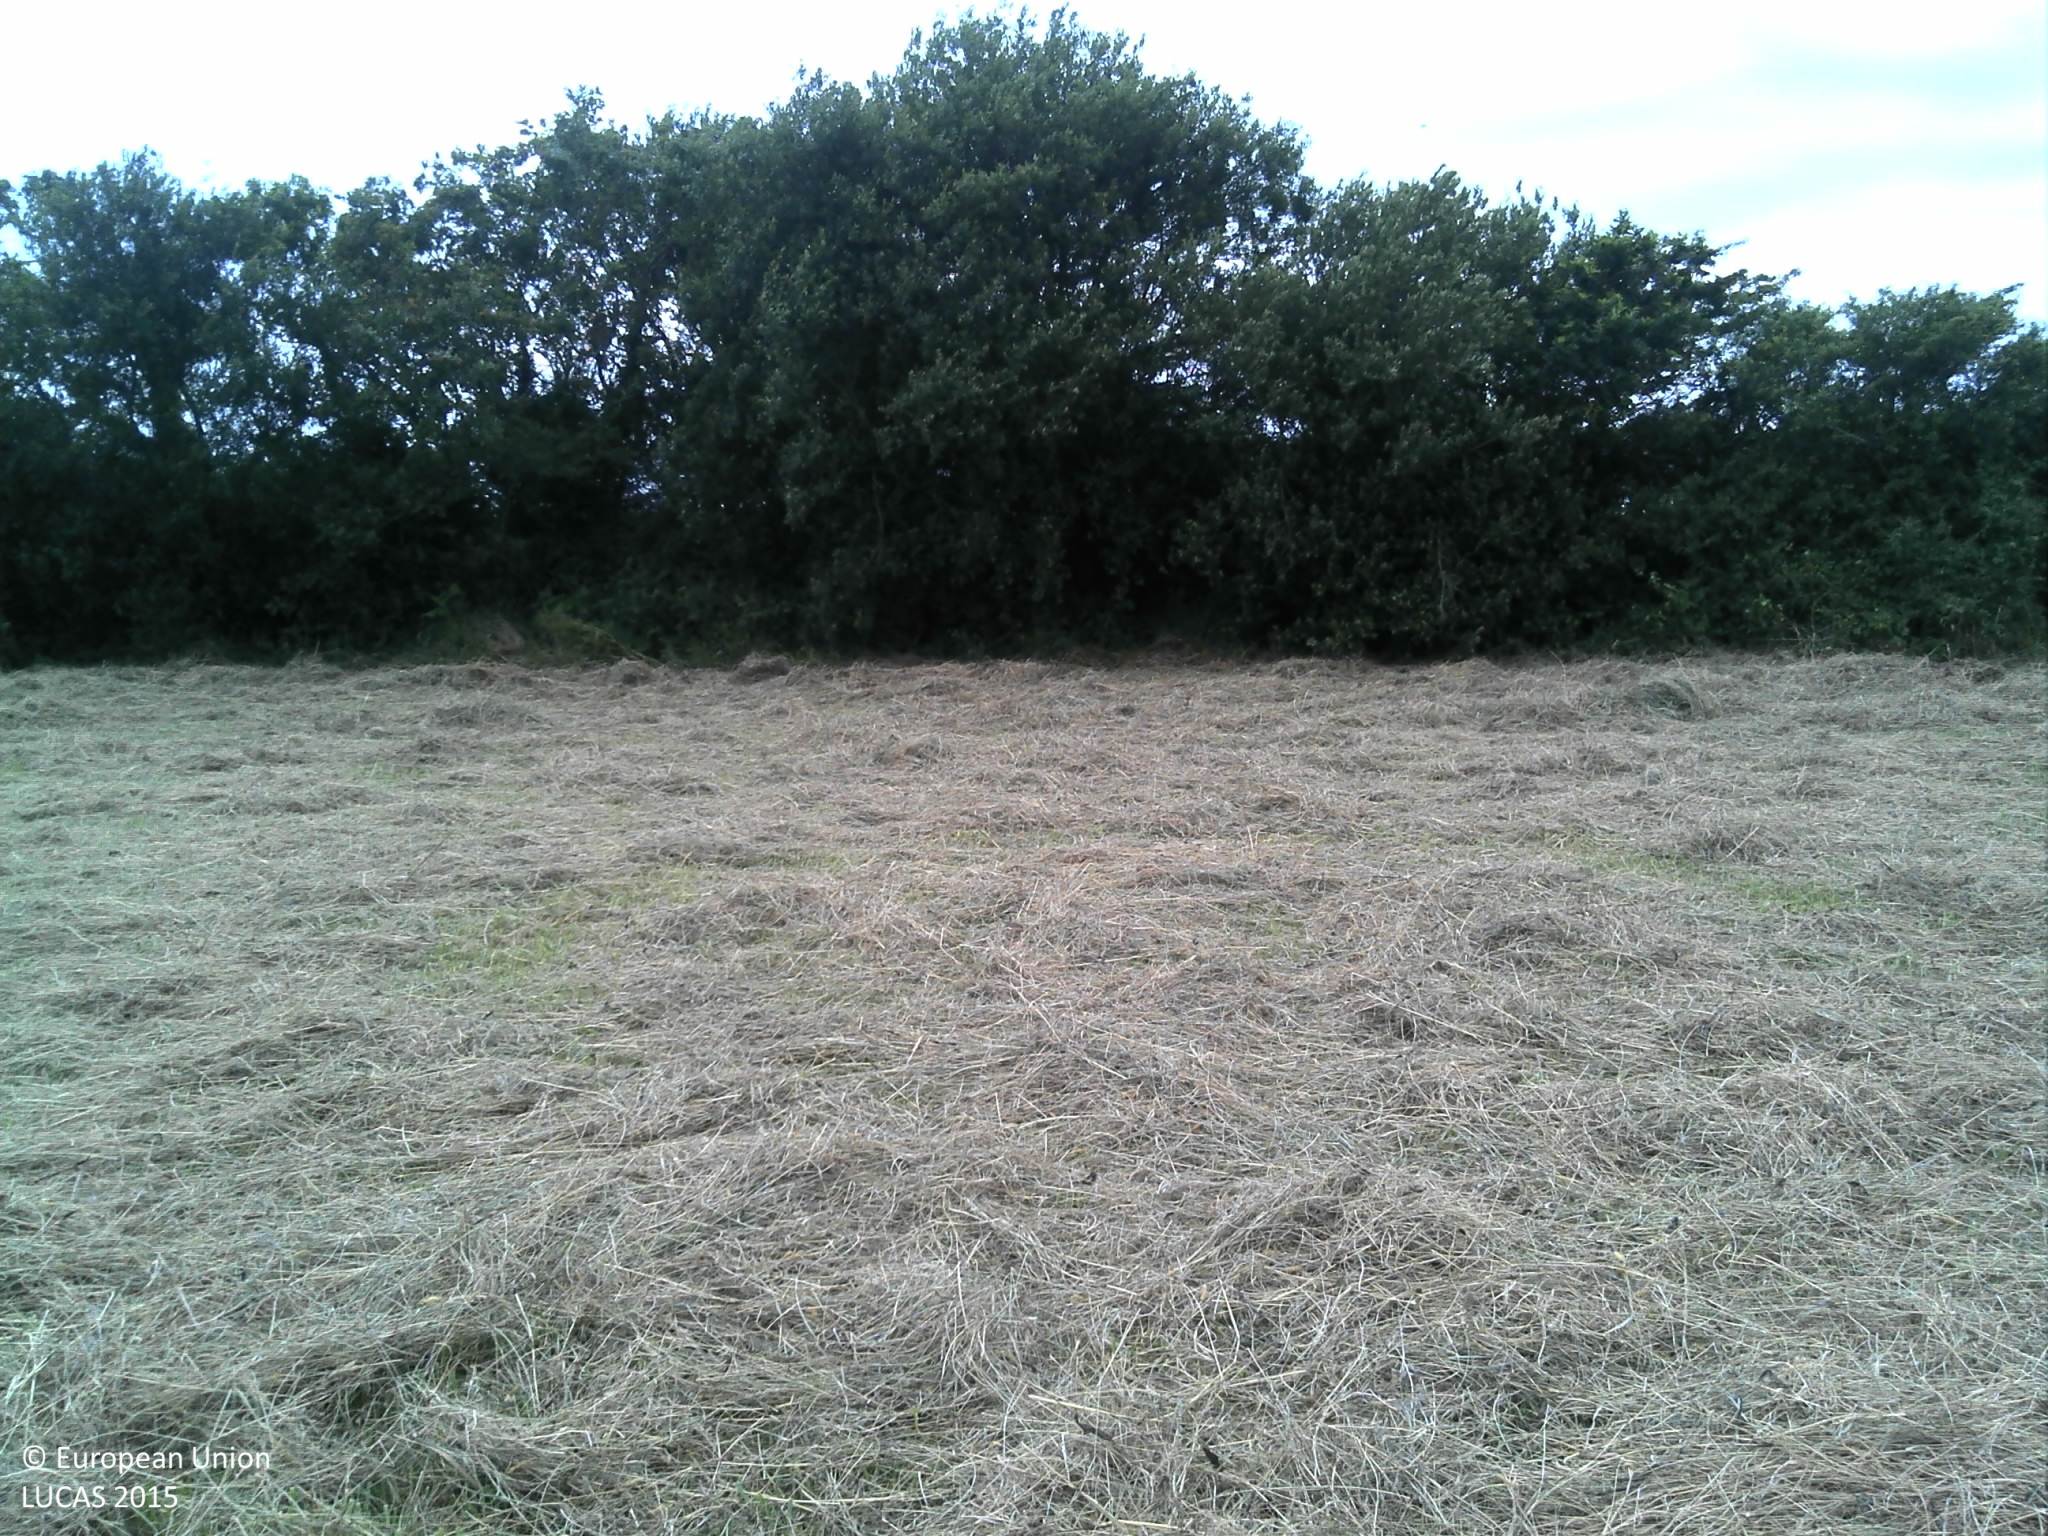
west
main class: Grassland
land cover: Grassland without tree/shrub cover
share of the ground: > 75 %
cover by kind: herbaceous plants 100 %
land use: Agriculture (excluding fallow land and kitchen gardens)
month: July
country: FR
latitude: 48.3938
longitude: -4.7578
